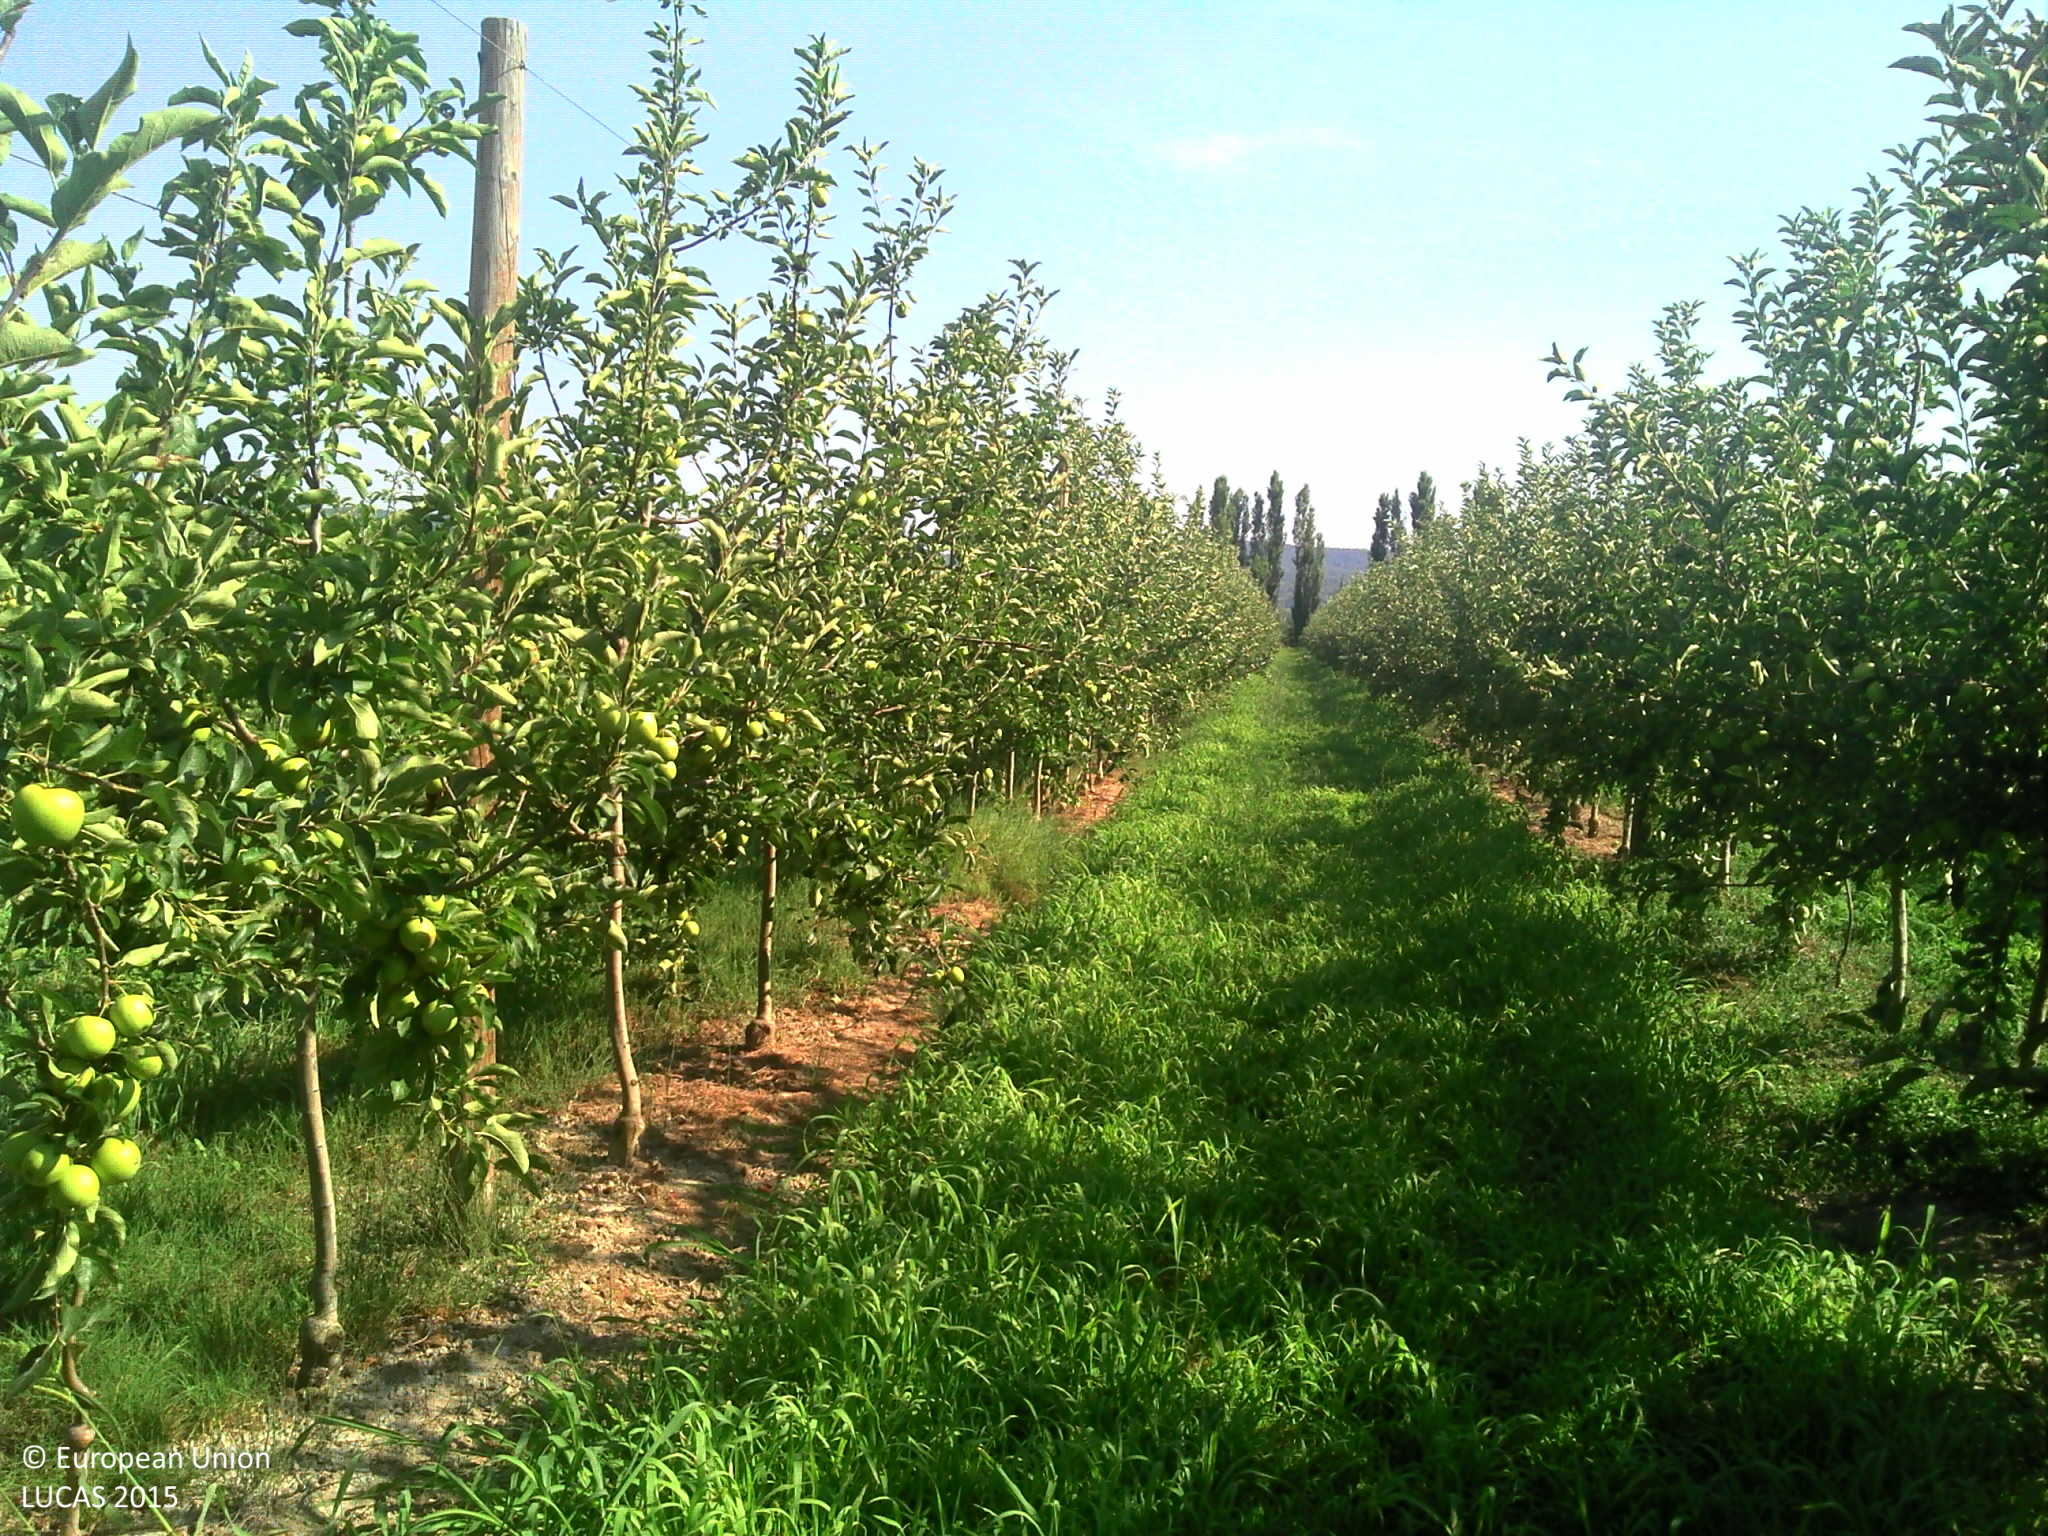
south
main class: Cropland
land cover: Apple fruit
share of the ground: 50 - 75 %
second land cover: Grassland without tree/shrub cover
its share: 25 - 50 %
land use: Agriculture (excluding fallow land and kitchen gardens)
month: July
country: FR
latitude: 43.8008
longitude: 4.7265
